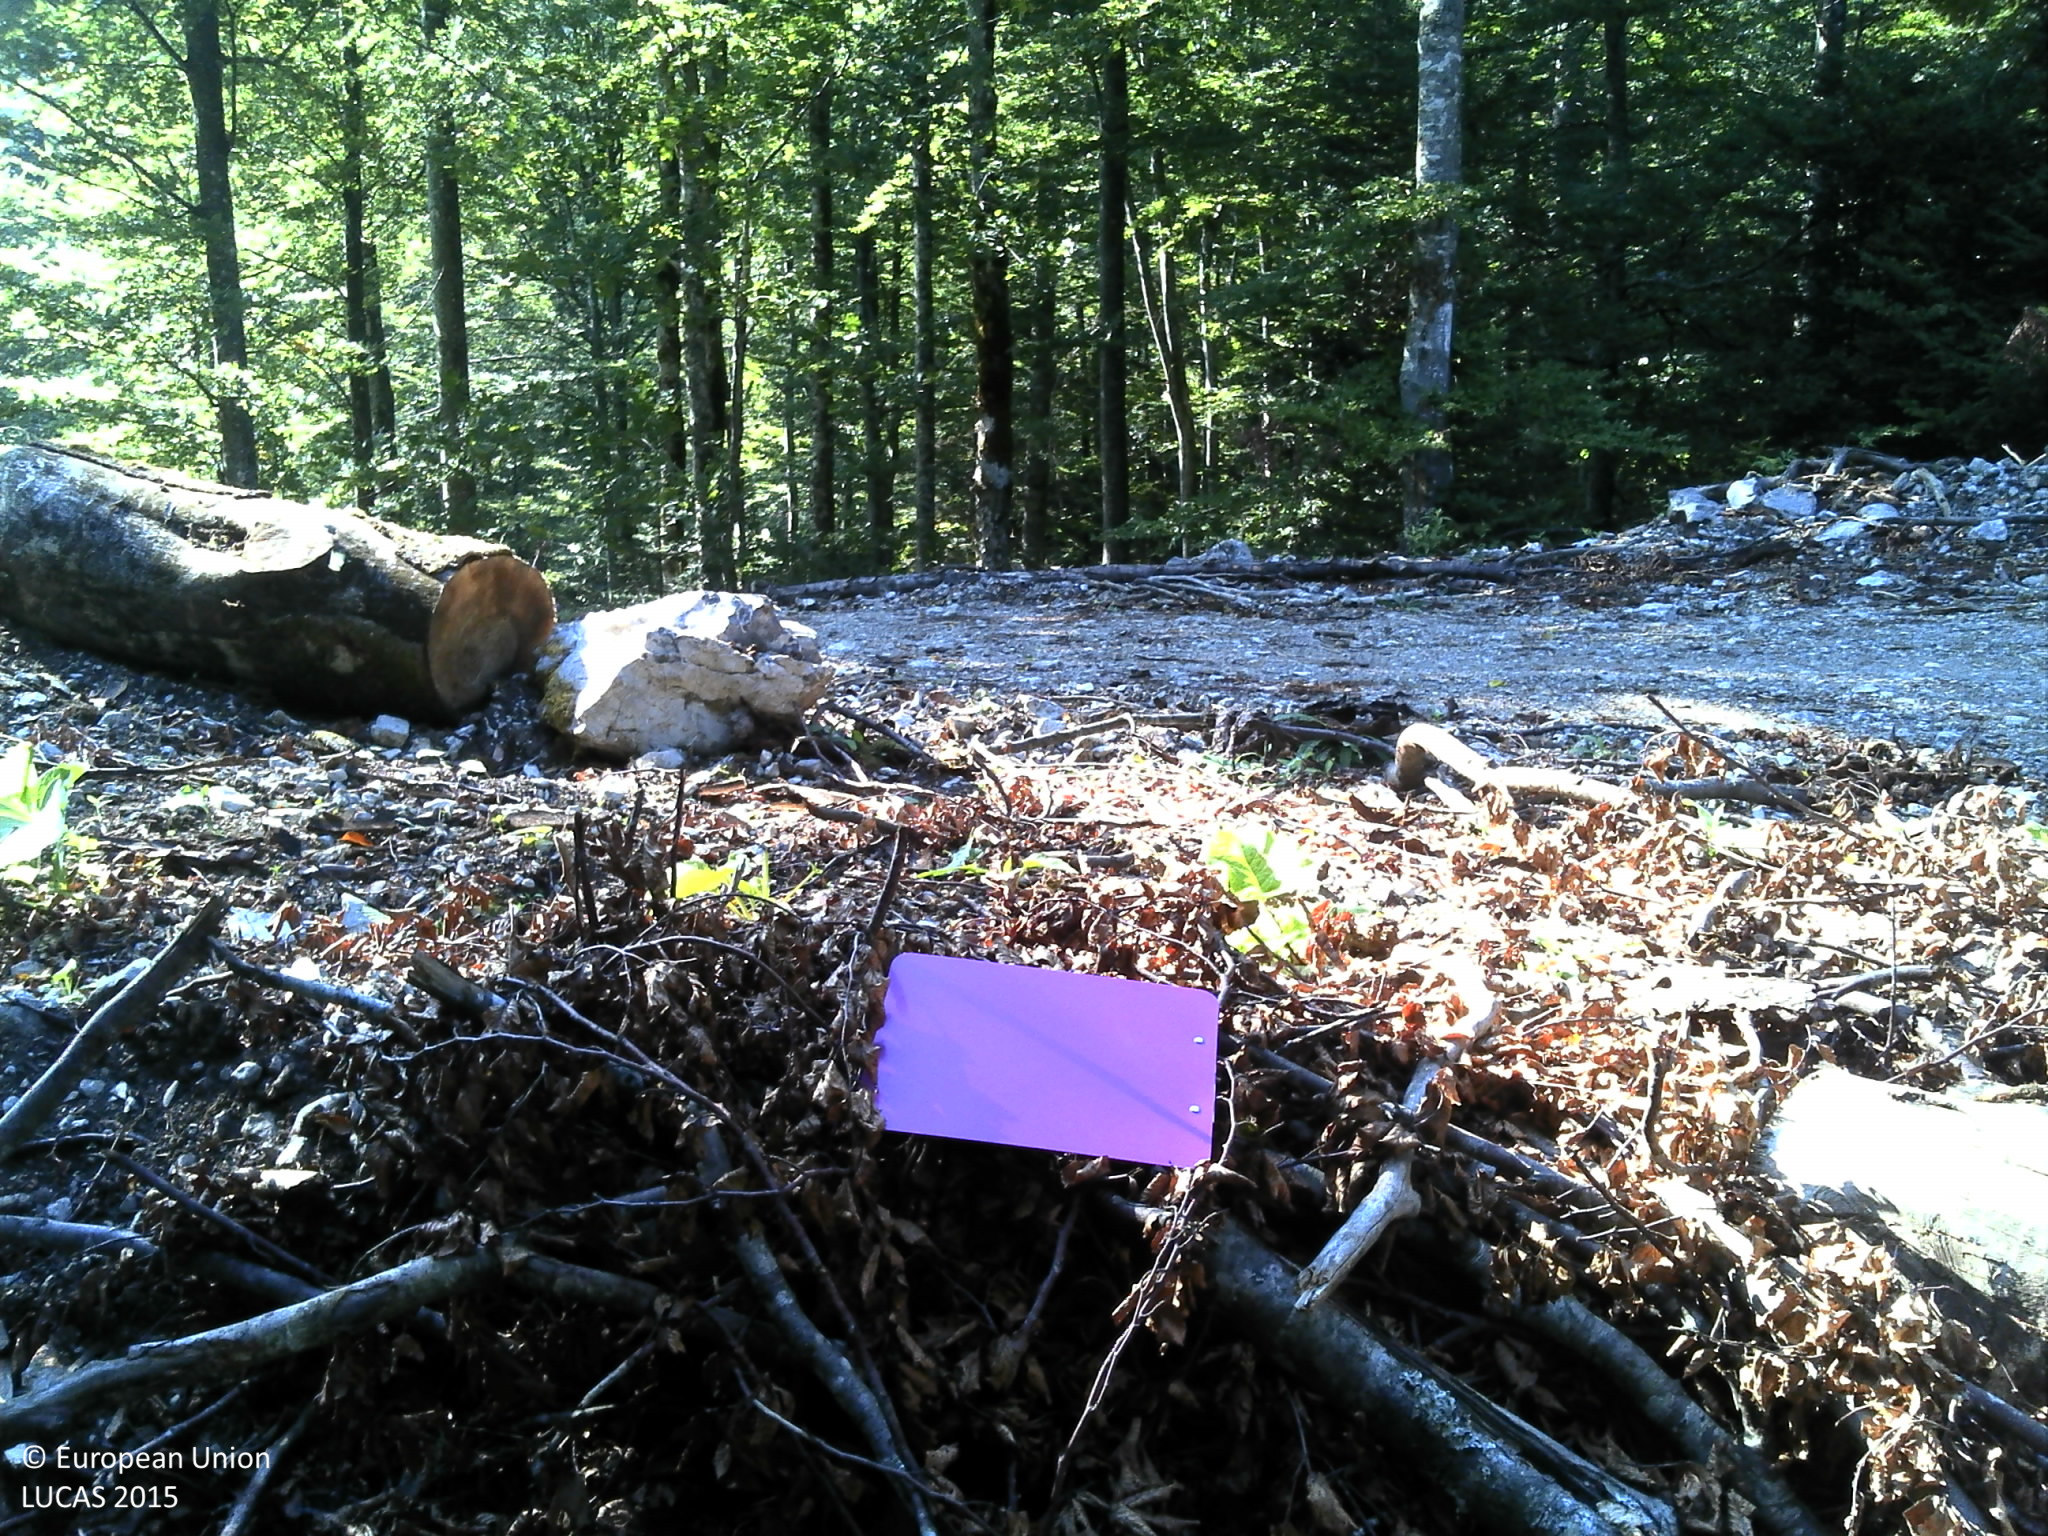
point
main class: Woodland
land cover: Broadleaved woodland
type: beech forest
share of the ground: > 75 %
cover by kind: broadleaved forest trees 100 %
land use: Forestry
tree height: > 5 m
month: September
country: HR
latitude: 45.2930
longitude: 15.0573
